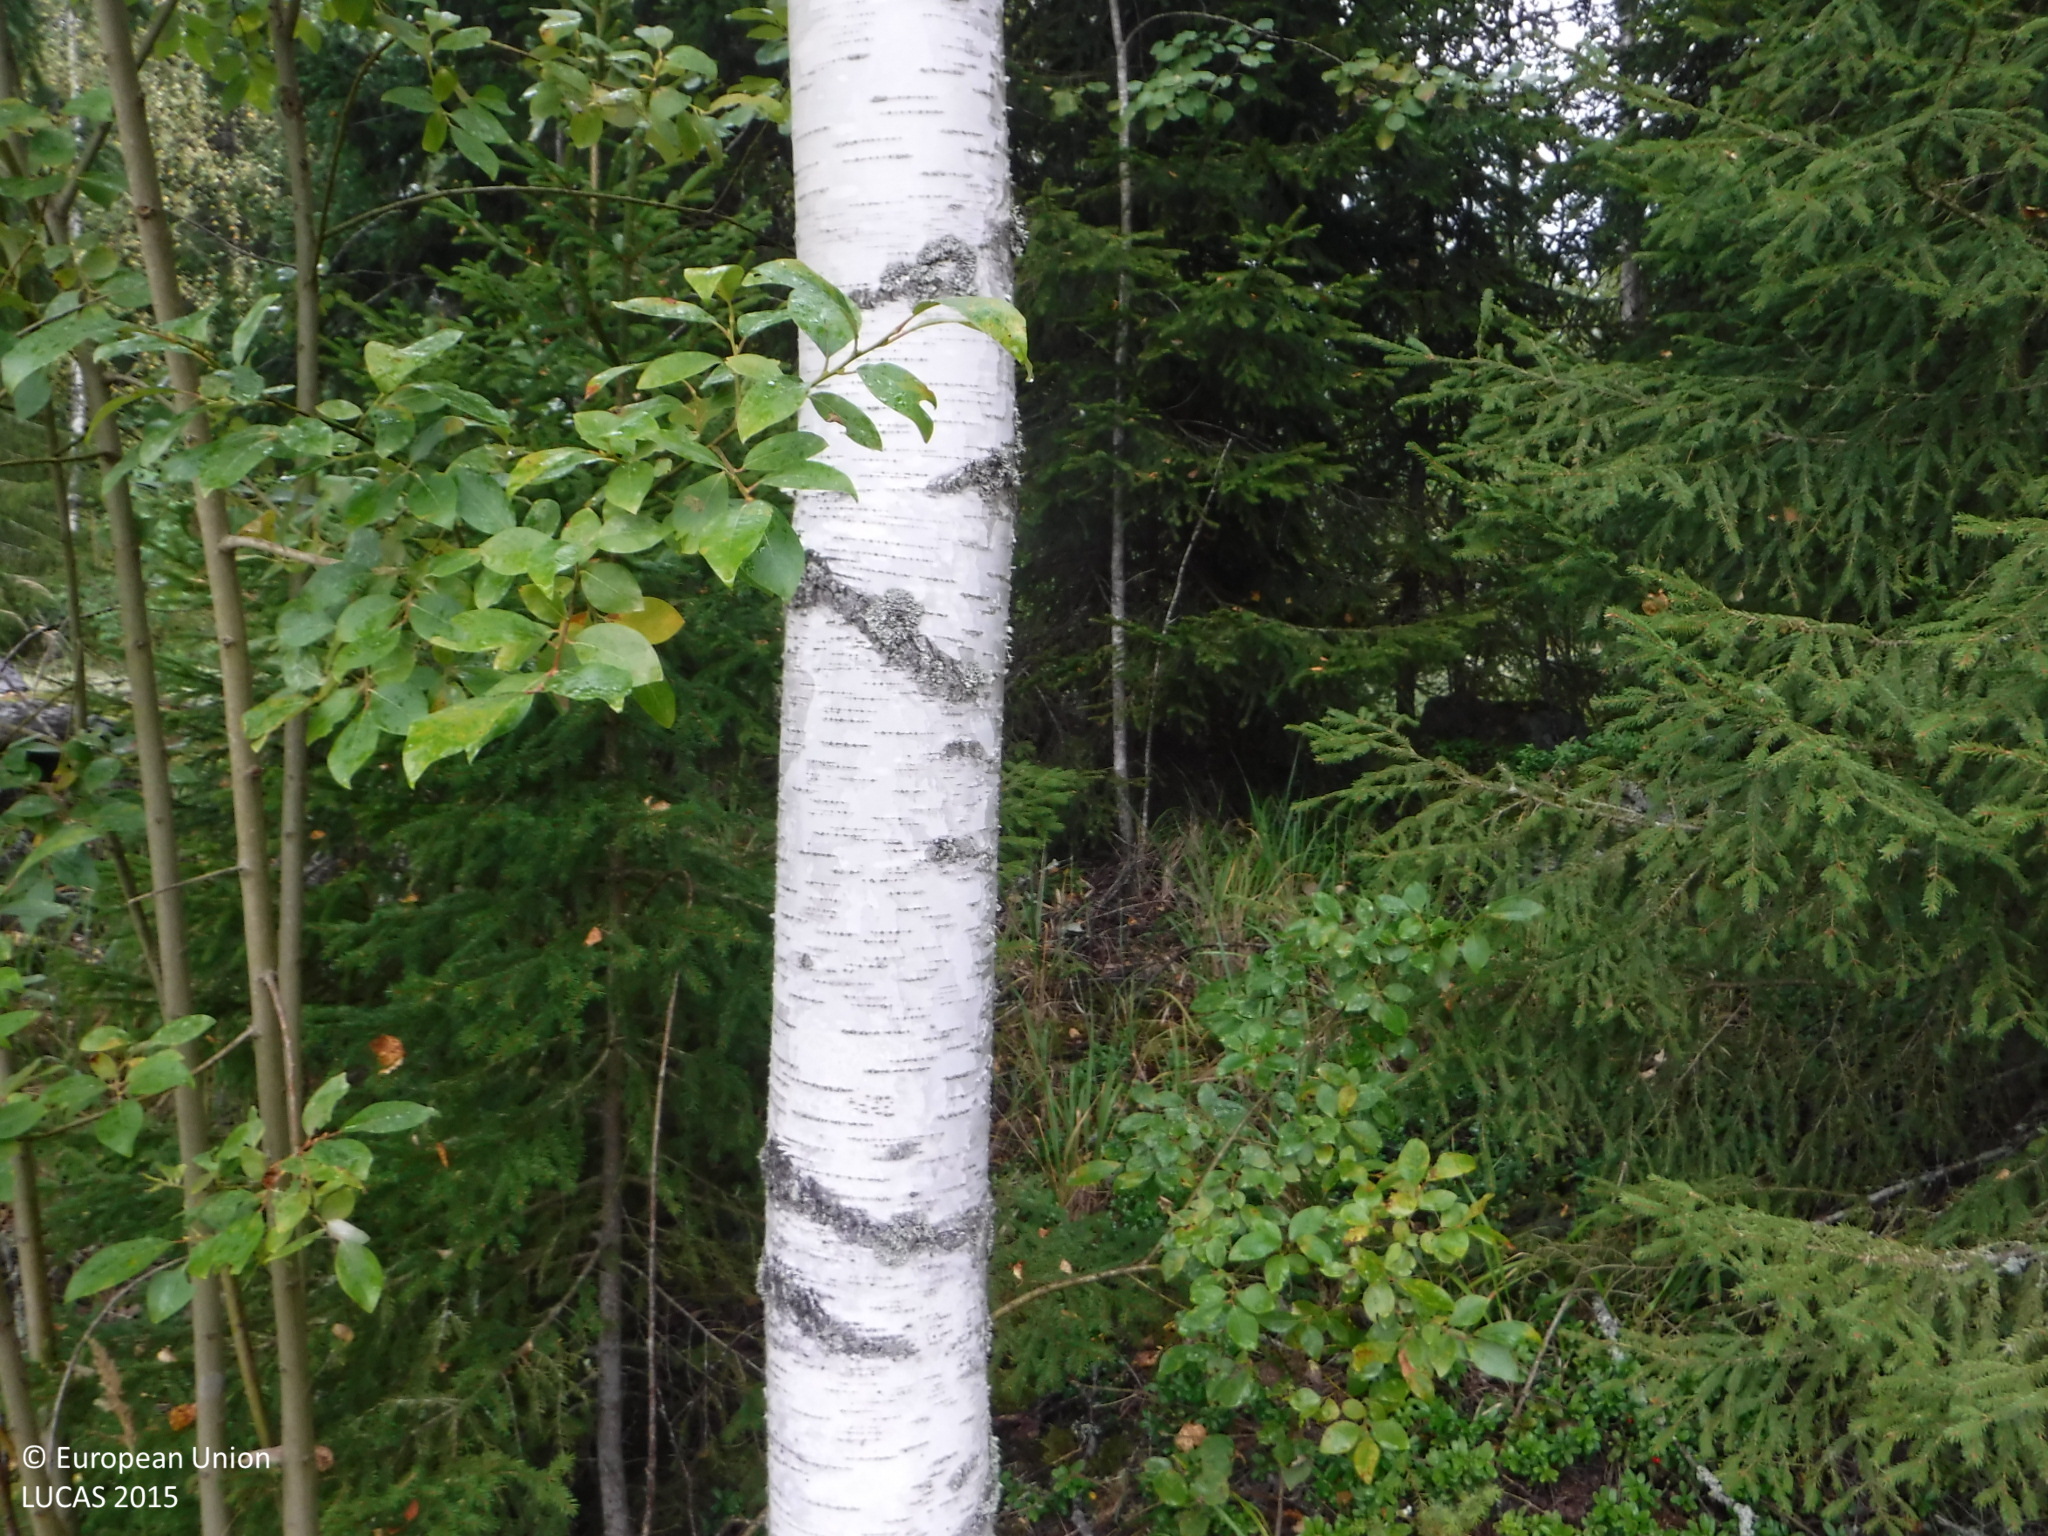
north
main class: Cropland
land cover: Common wheat
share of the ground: > 75 %
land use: Agriculture (excluding fallow land and kitchen gardens)
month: August
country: FI
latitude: 61.2415
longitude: 22.9850
